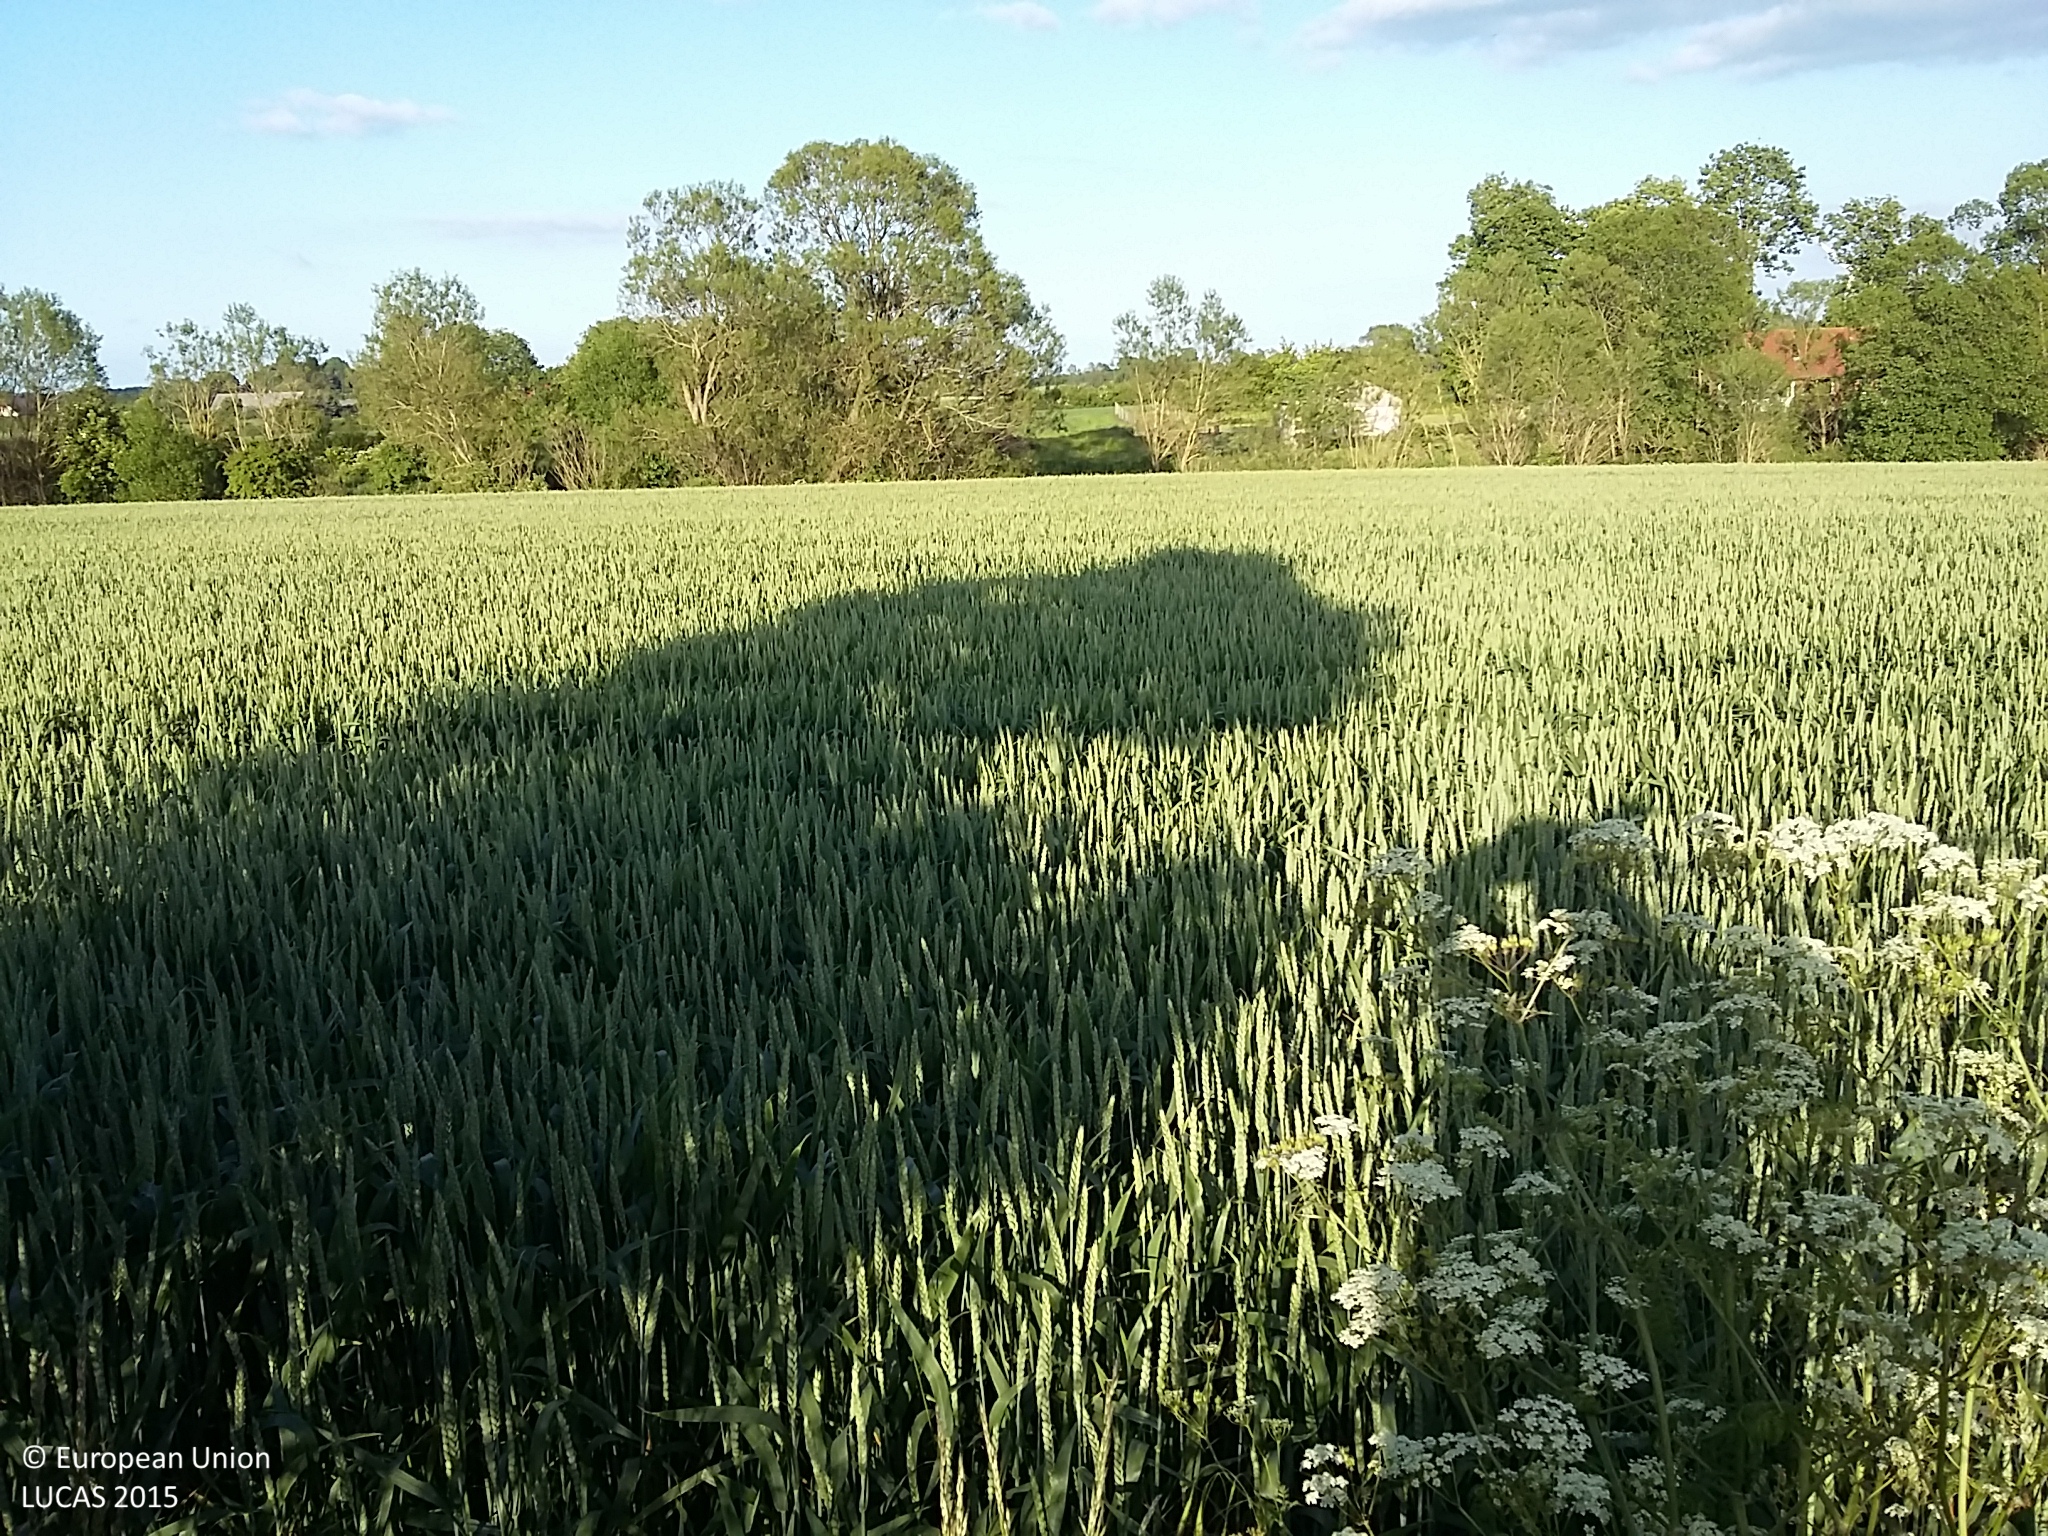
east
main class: Cropland
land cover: Rape and turnip rape
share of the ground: > 75 %
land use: Agriculture (excluding fallow land and kitchen gardens)
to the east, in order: Rape and turnip rape; Grass margins; Common wheat; Tracks; Spontaneously vegetated surfaces; Single bushes/trees; Inland fresh water bodies; Spontaneously vegetated surfaces; Broadleaved woodland; Tracks; Grass margins; Oats; Managed hedges; Barley
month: June
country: DK
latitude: 55.2150
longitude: 10.7381
